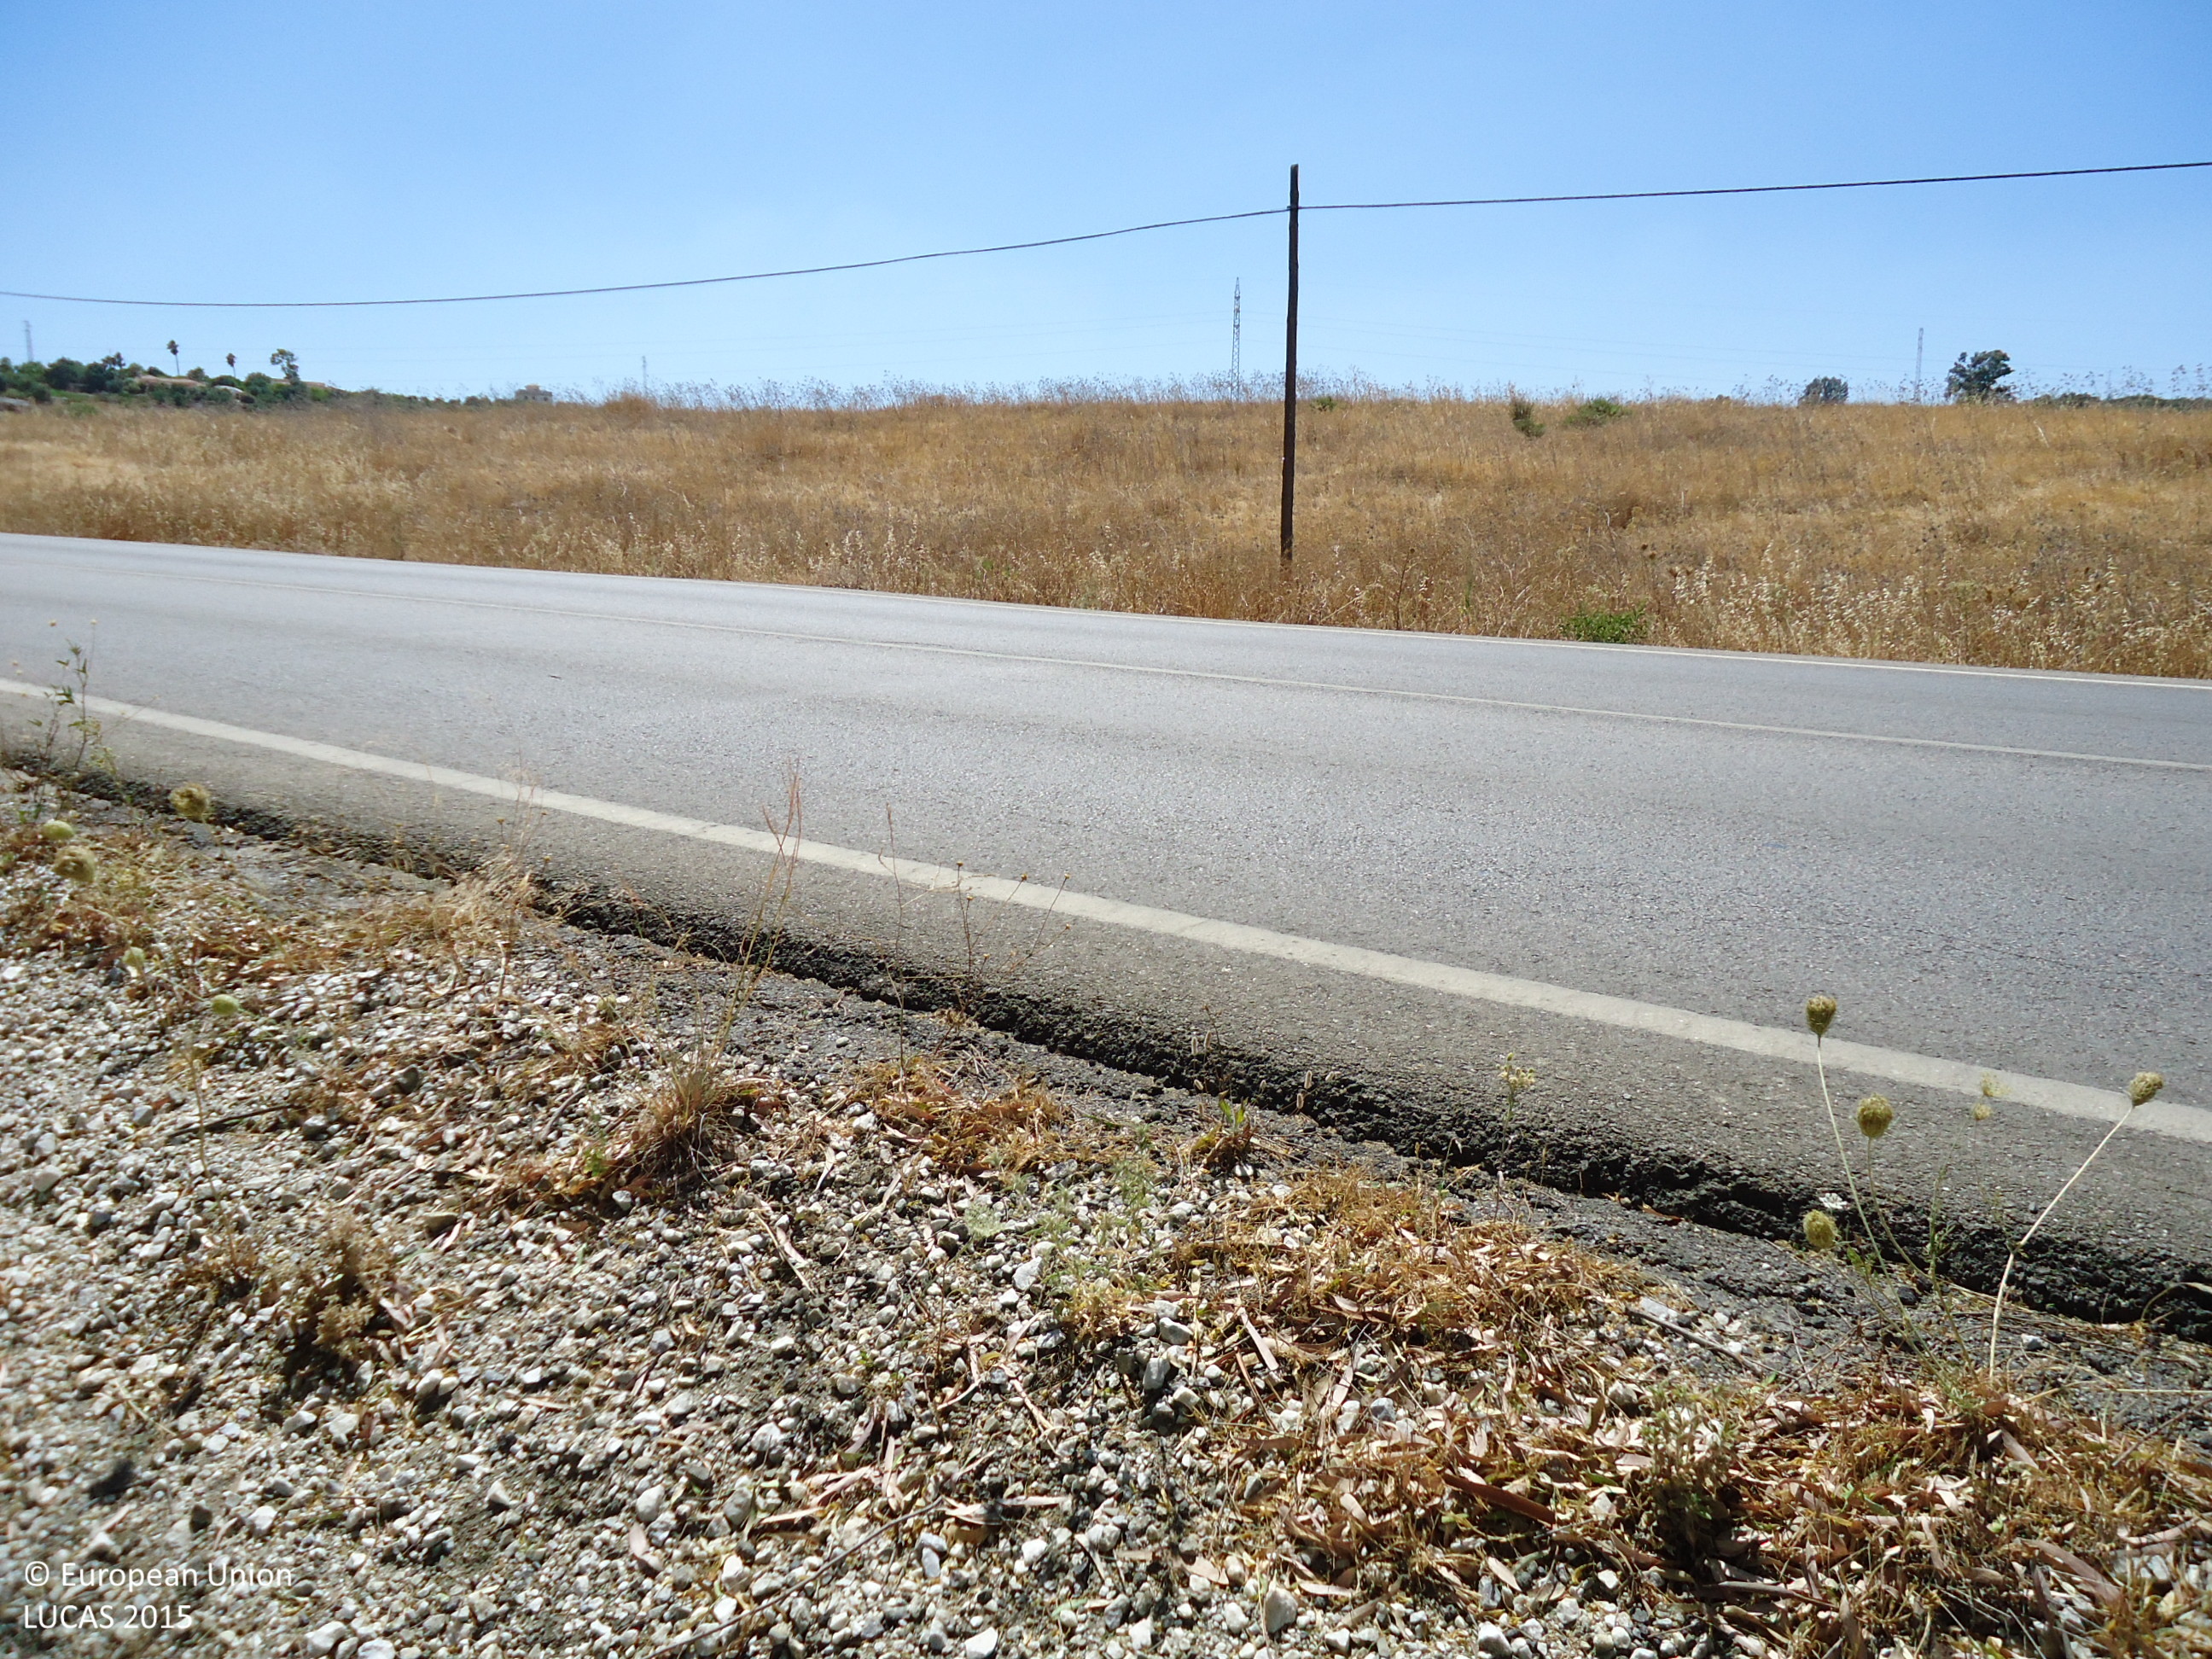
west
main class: Woodland
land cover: Broadleaved woodland
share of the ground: 25 - 50 %
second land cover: Grassland without tree/shrub cover
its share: > 75 %
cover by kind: herbaceous plants 70 %, broadleaved forest trees 30 %
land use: Forestry
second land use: Agriculture (excluding fallow land and kitchen gardens)
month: June
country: ES
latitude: 36.7779
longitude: -4.7283
